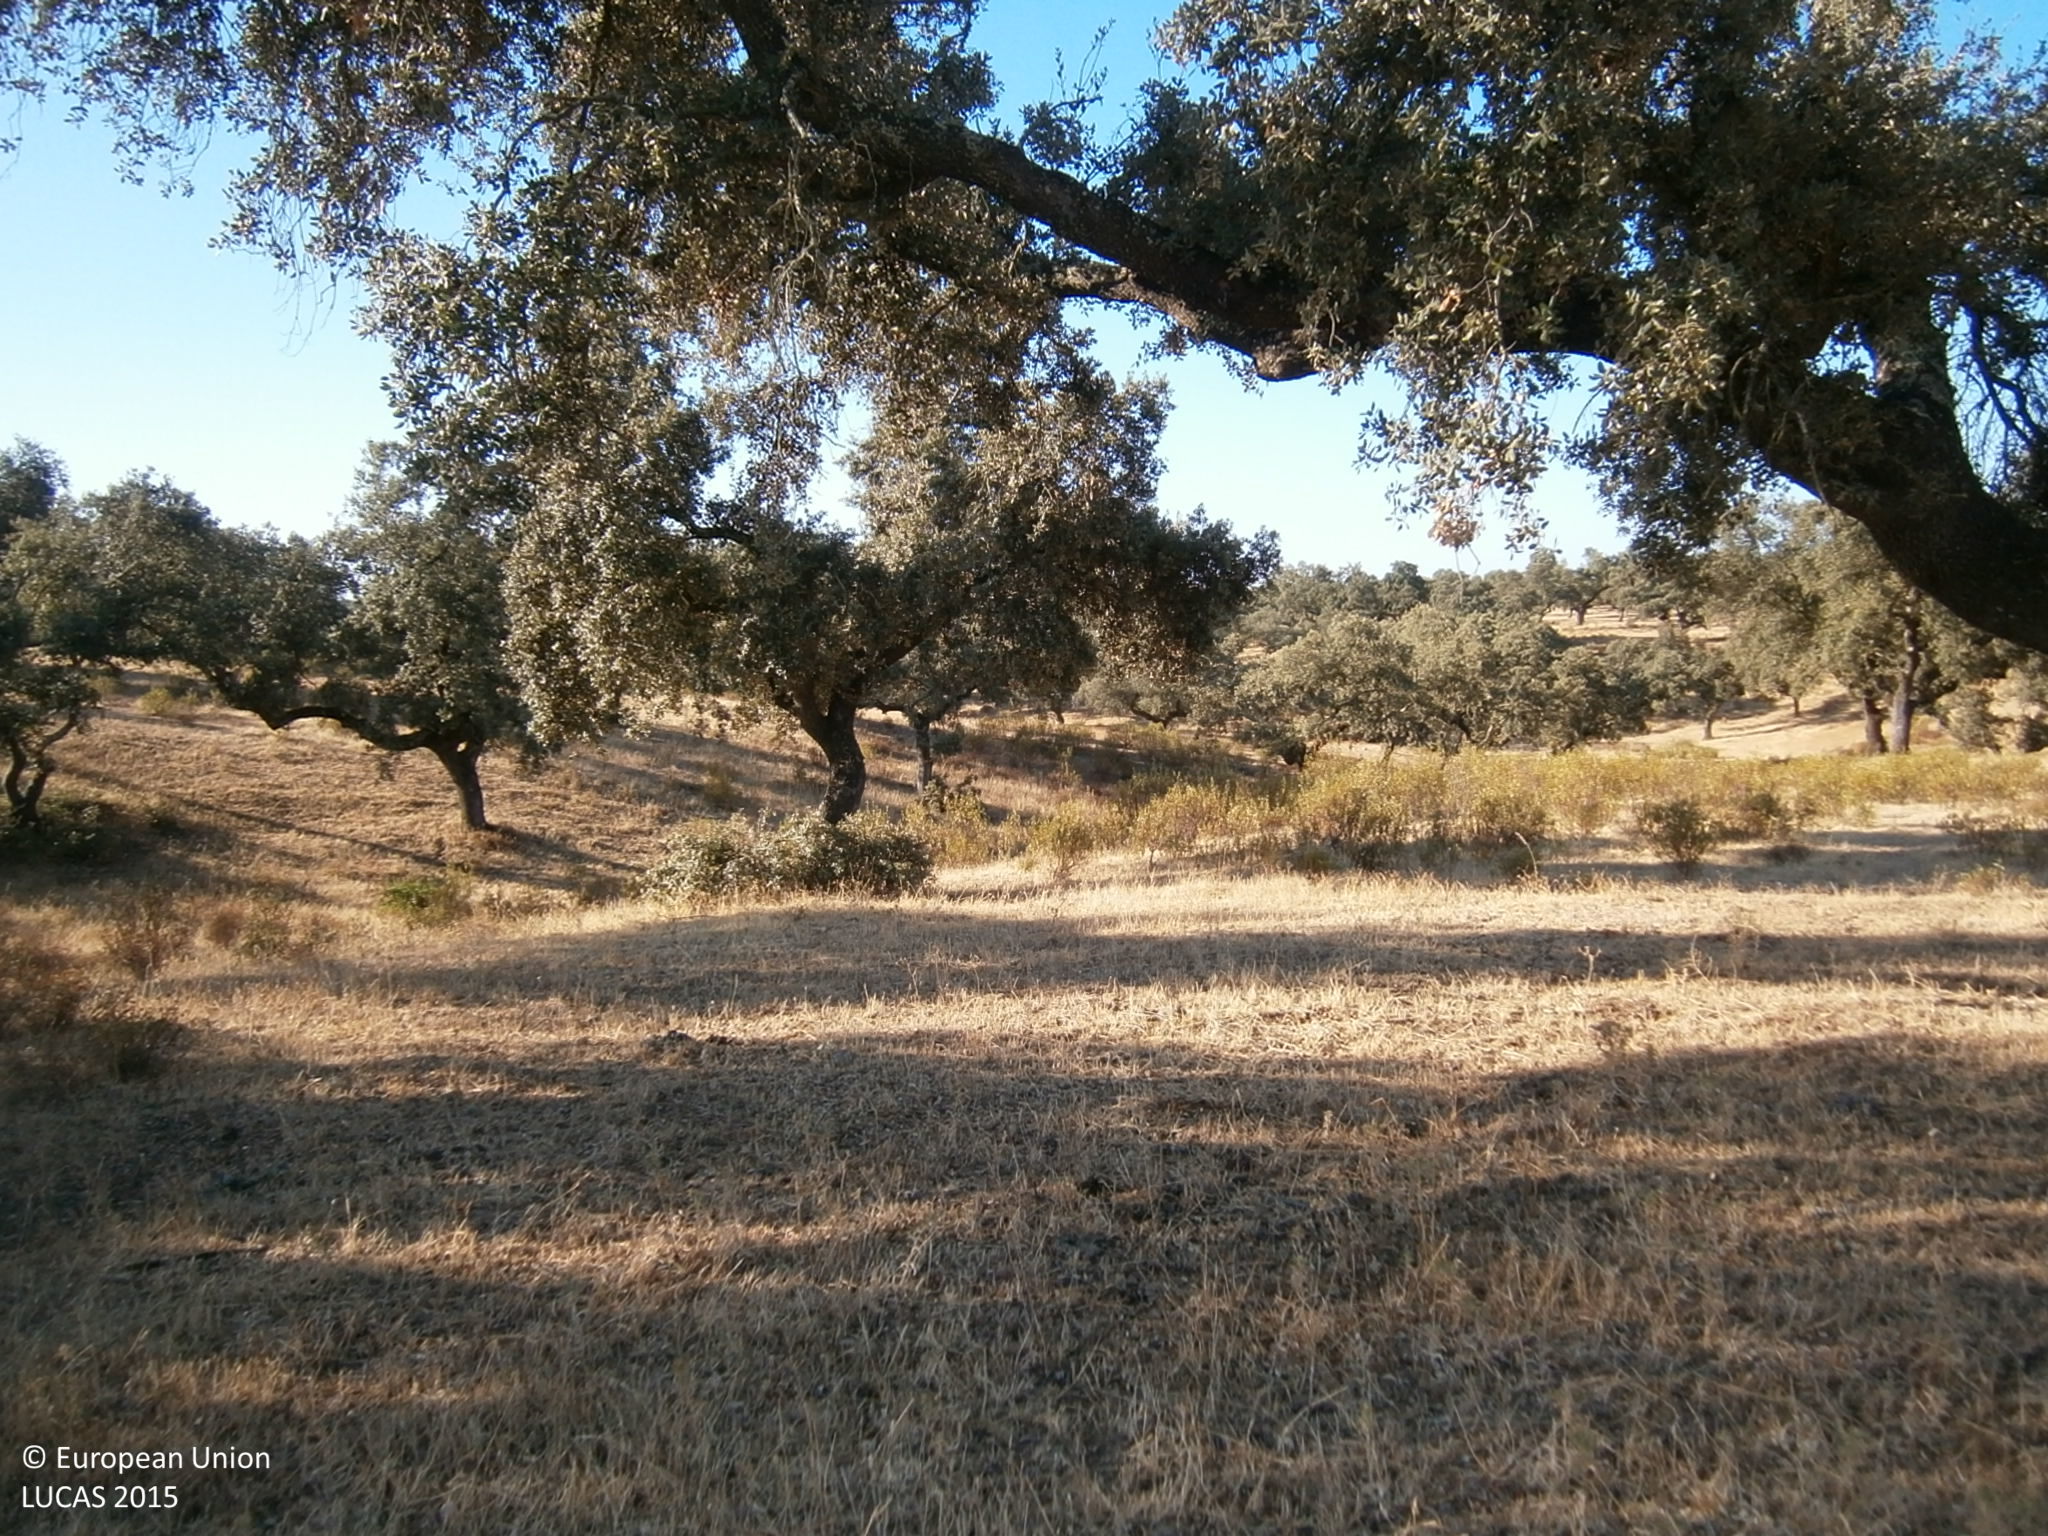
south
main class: Woodland
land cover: Broadleaved woodland
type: broadleaved evergreen forest
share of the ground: > 75 %
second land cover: Shrubland without tree cover
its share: < 10 %
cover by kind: broadleaved forest trees 70 %, herbaceous plants 20 %, shrubs 10 %
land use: Agriculture (excluding fallow land and kitchen gardens)
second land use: Forestry
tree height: > 5 m
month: July
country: ES
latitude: 38.6565
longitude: -7.2278
